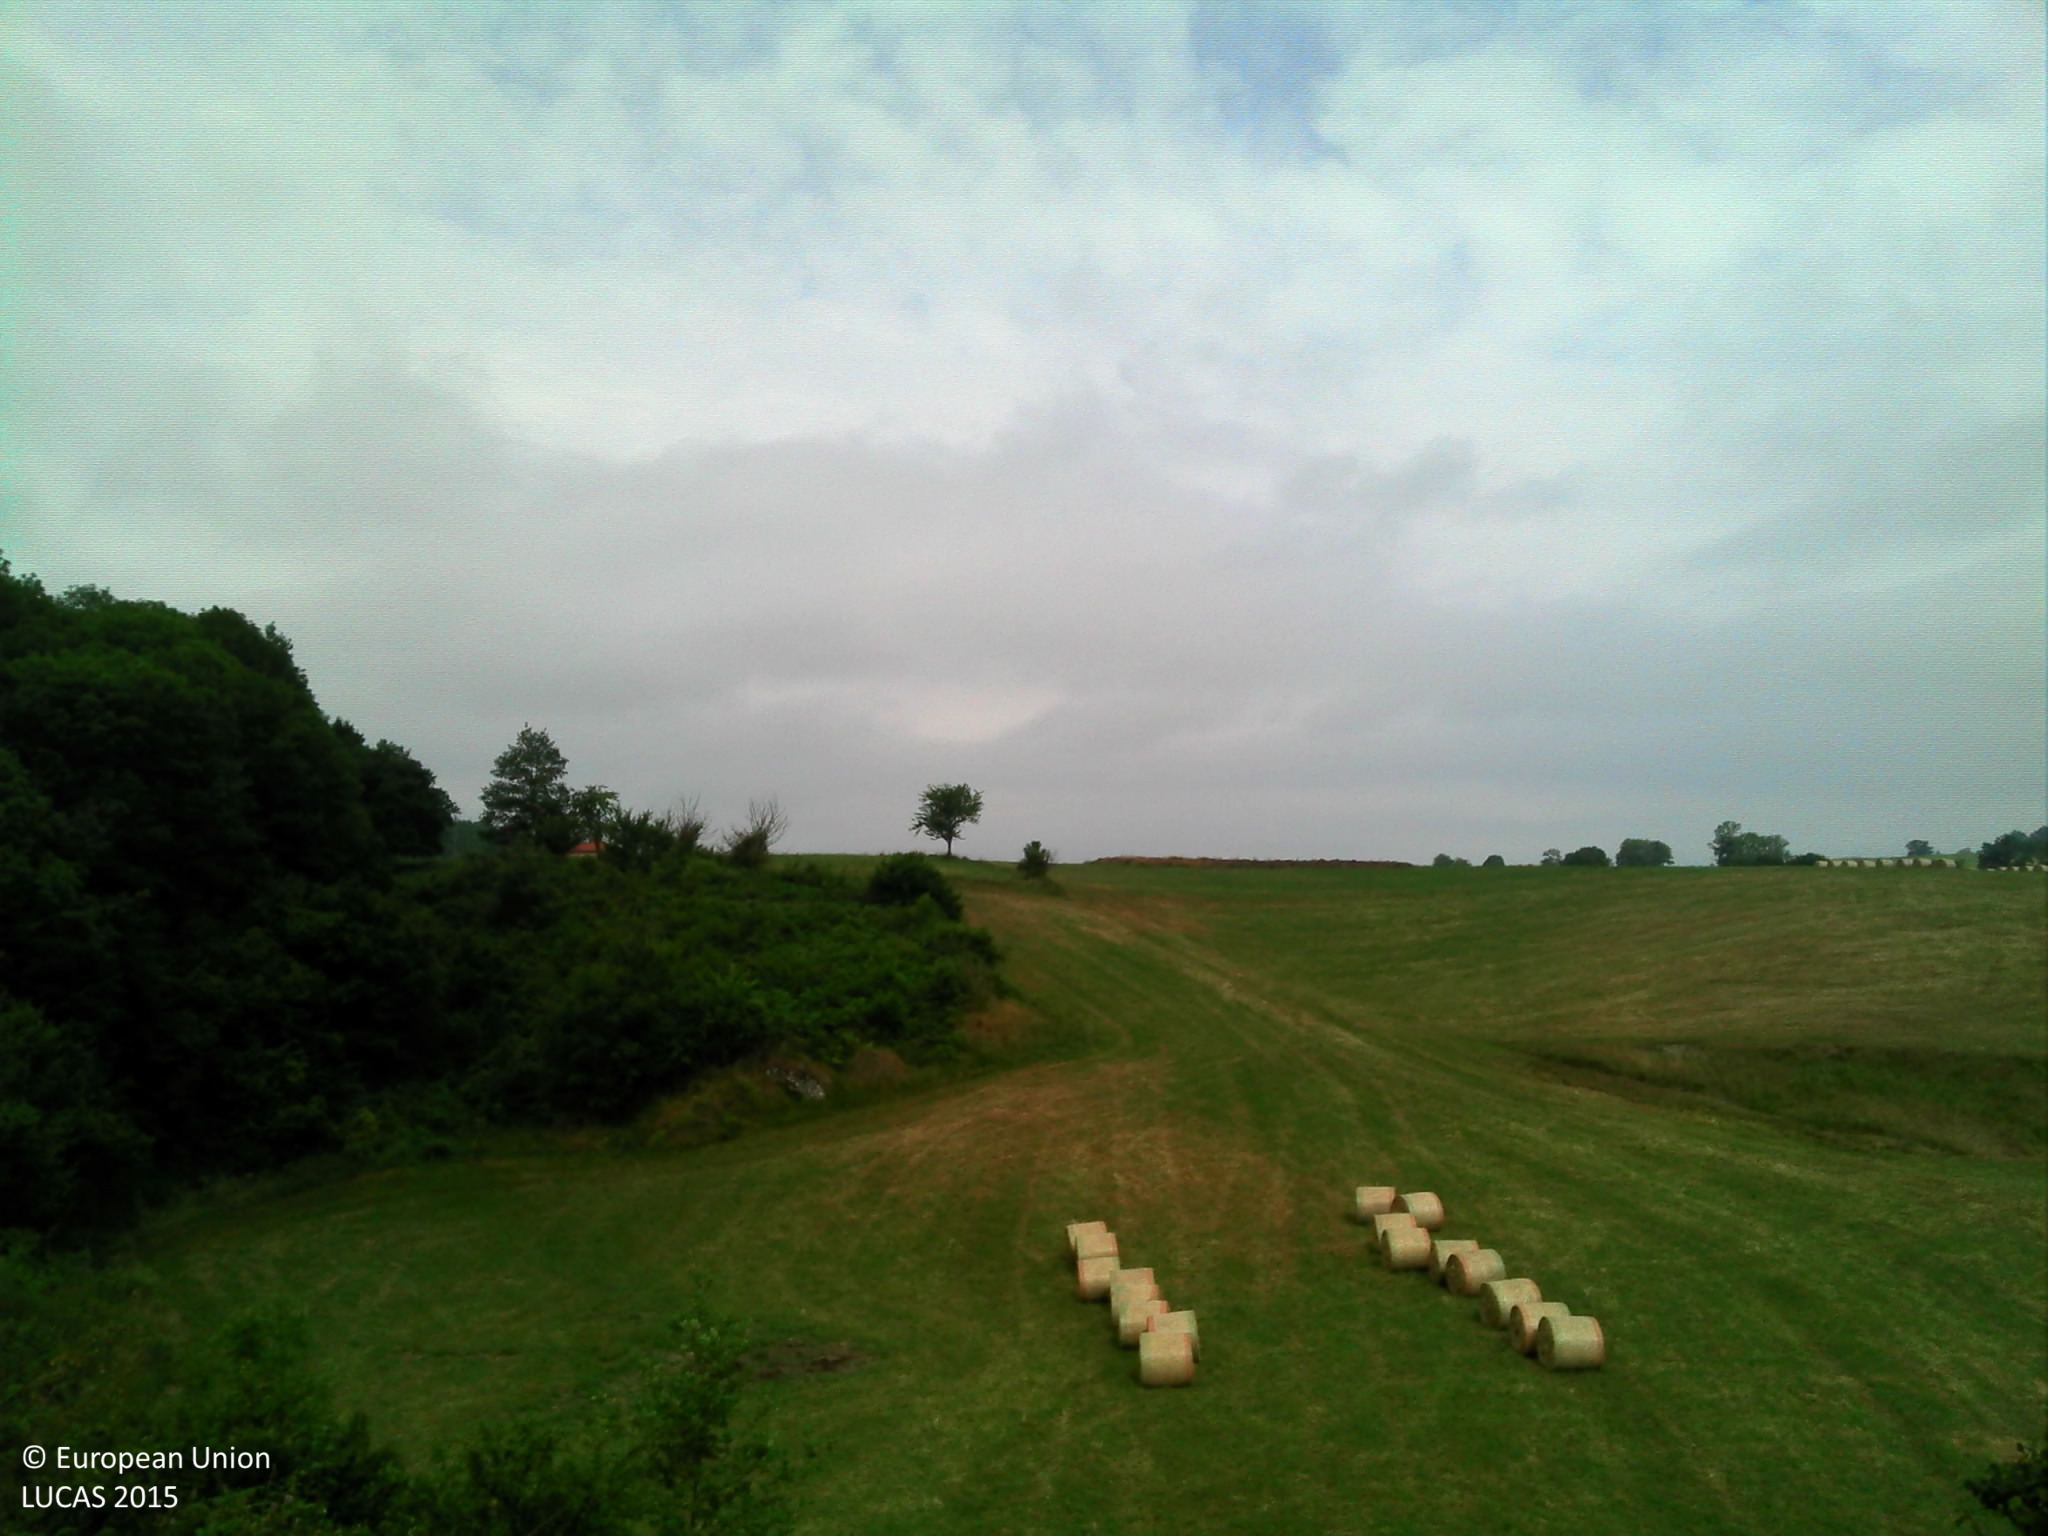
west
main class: Grassland
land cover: Grassland without tree/shrub cover
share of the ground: > 75 %
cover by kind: herbaceous plants 100 %
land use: Agriculture (excluding fallow land and kitchen gardens)
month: July
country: FR
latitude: 43.0222
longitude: 1.5022
